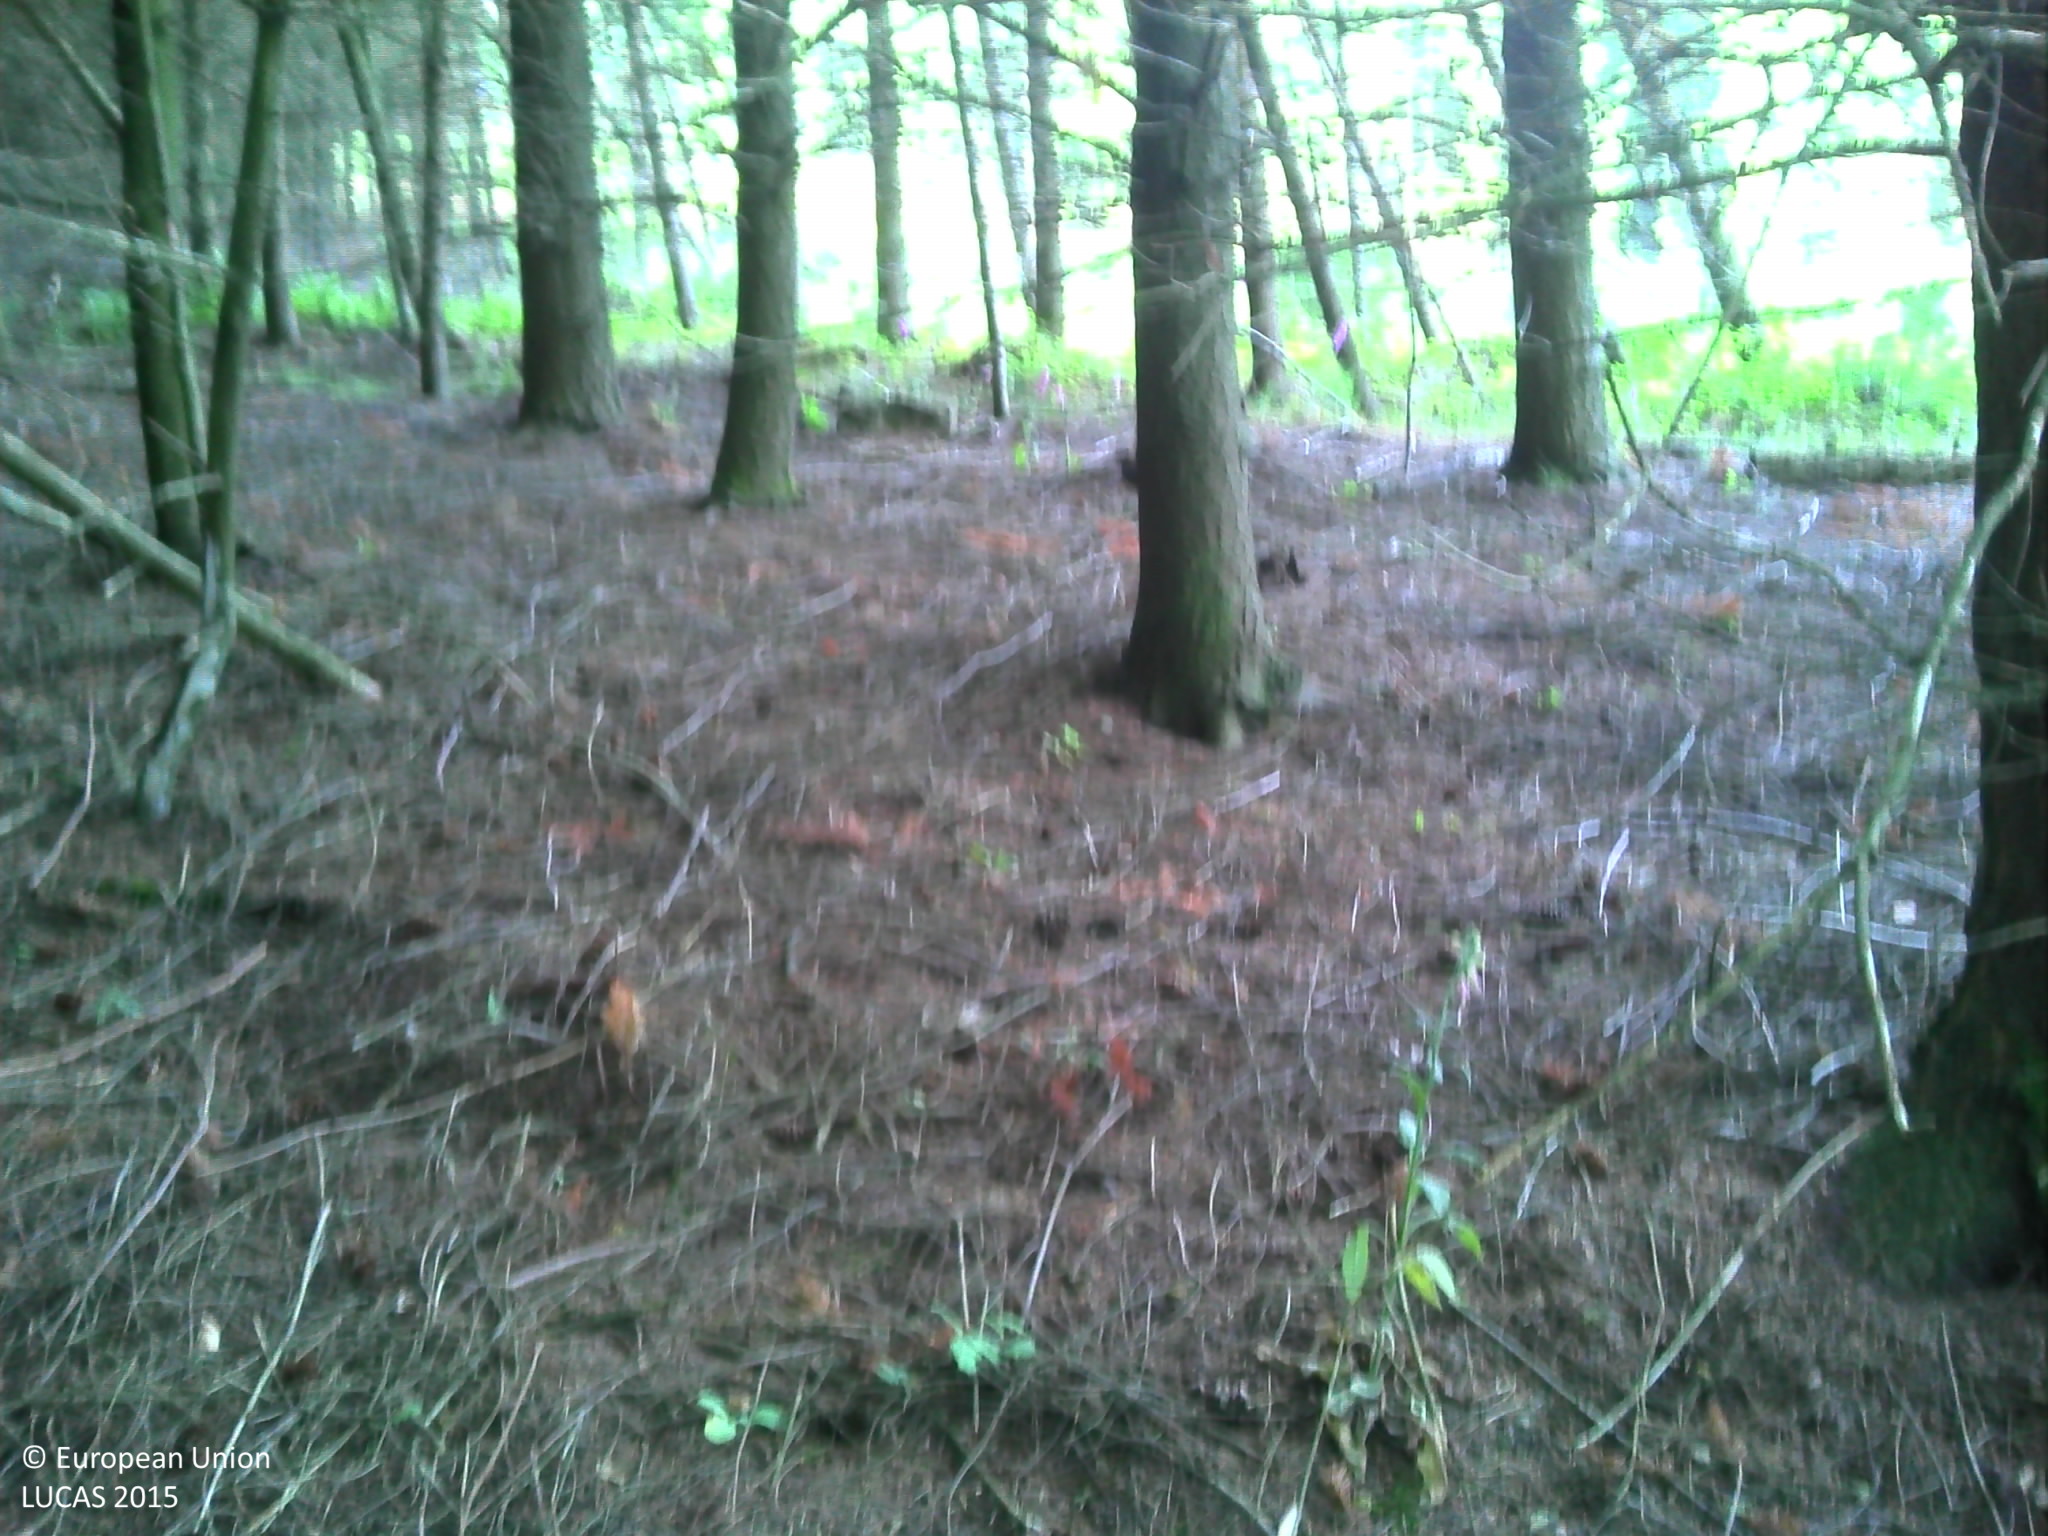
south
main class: Woodland
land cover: Spruce dominated coniferous woodland
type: exotic forest
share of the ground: > 75 %
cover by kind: coniferous forest trees 100 %
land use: Forestry
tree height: > 5 m
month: June
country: FR
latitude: 46.3324
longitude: 4.4287
